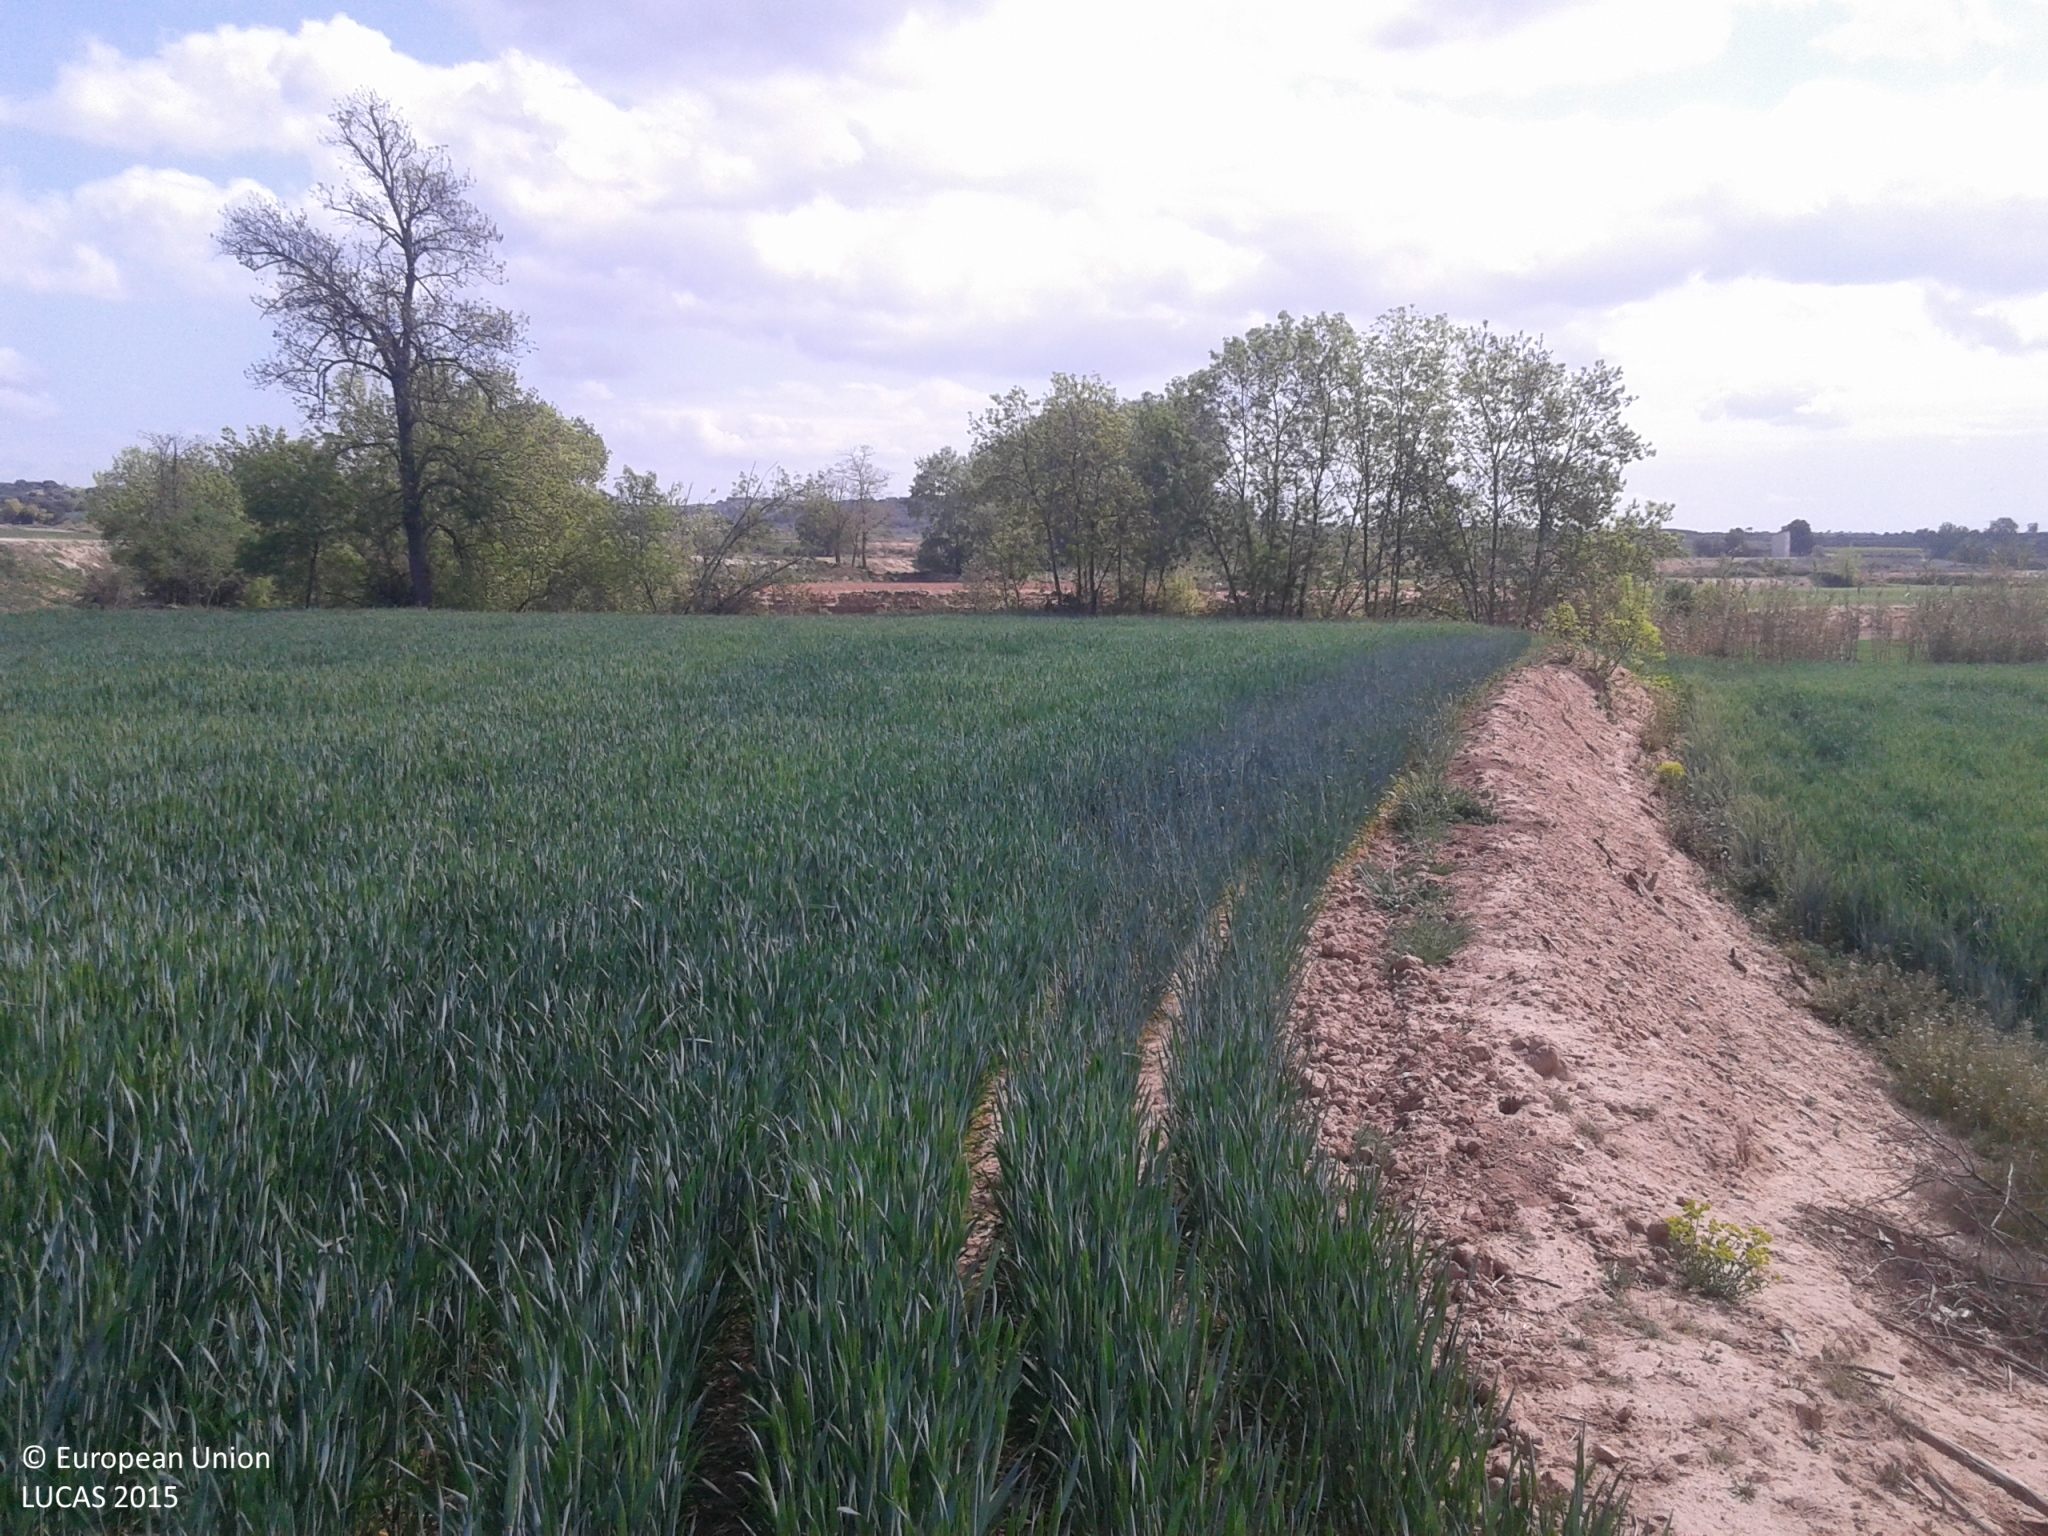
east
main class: Cropland
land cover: Oats
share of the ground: > 75 %
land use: Agriculture (excluding fallow land and kitchen gardens)
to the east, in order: Oats; Broadleaved woodland; Lucerne; Grass margins; Dry stone walls; Other bare soil; Dry stone walls; Dry pulses; Grassland with sparse tree/shrub cover; Dry pulses
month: April
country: ES
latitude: 41.7352
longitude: 1.1037
